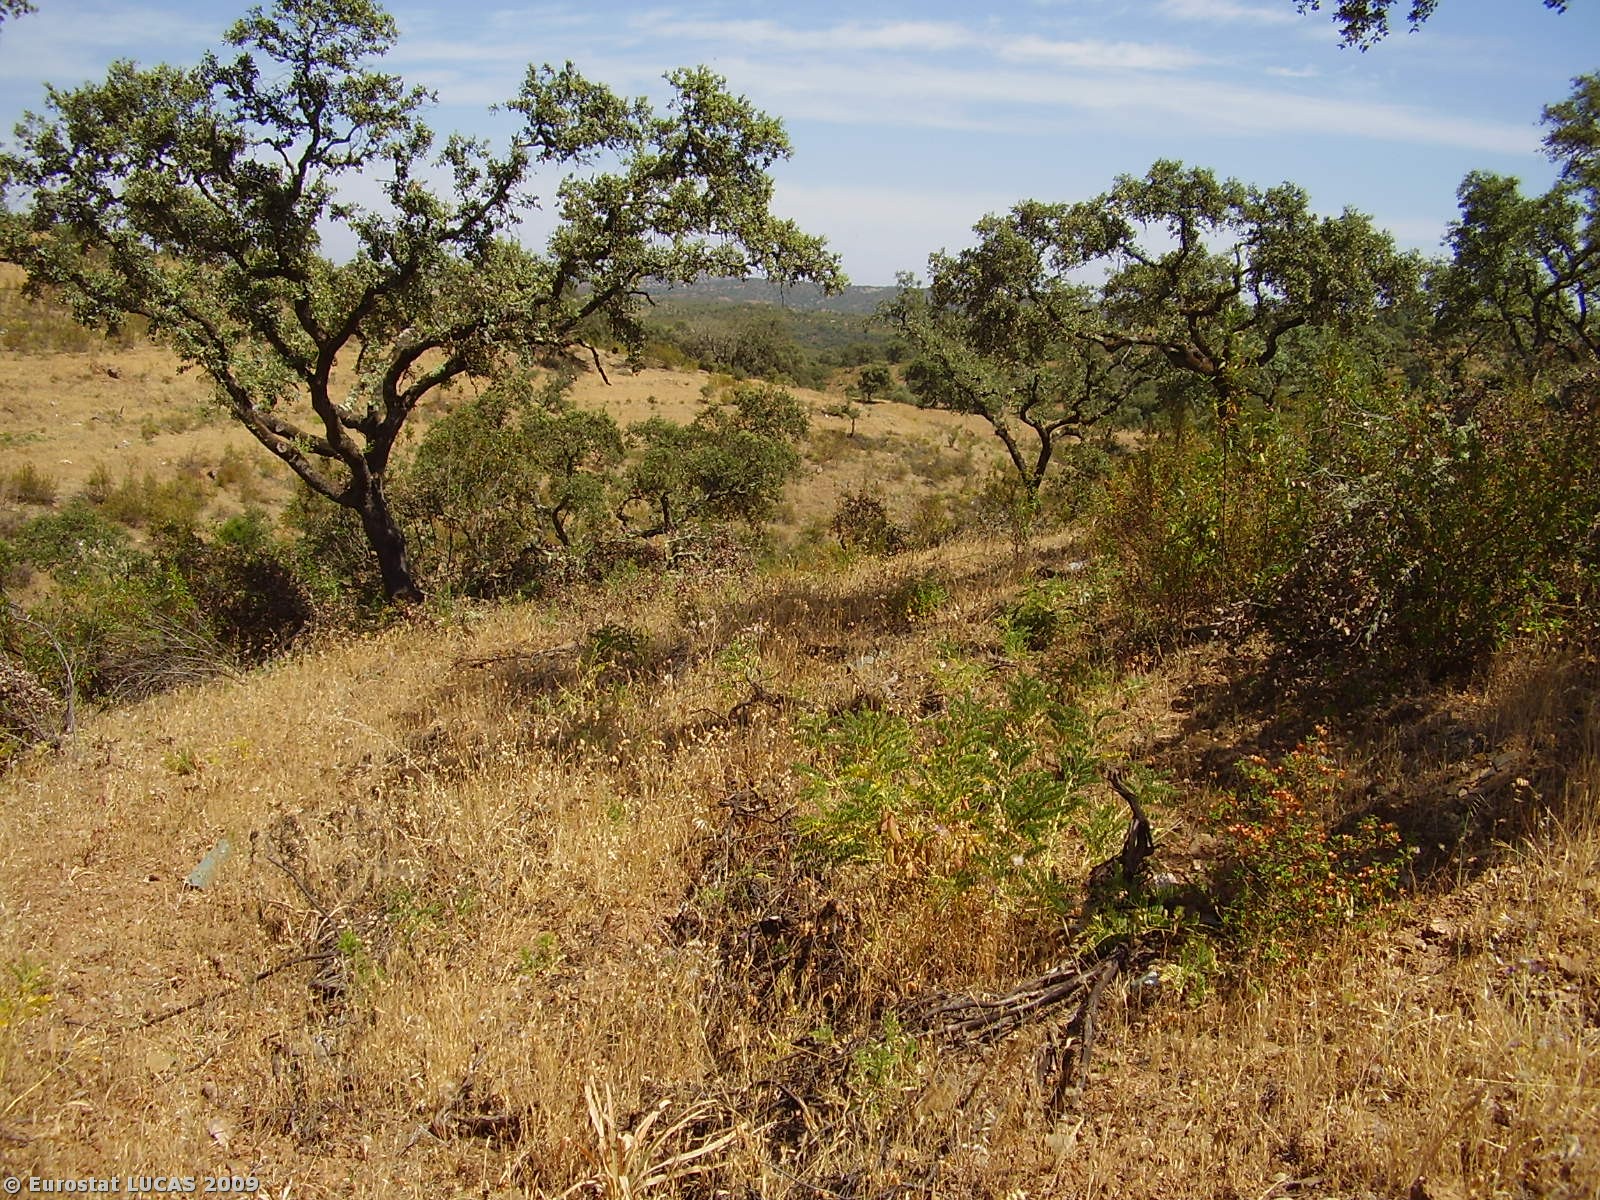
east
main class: Woodland
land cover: Broadleaved woodland
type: broadleaved evergreen forest
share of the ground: 50 - 75 %
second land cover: Spontaneously vegetated surfaces
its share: 50 - 75 %
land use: Forestry
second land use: Fallow land
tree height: > 5 m
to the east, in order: Broadleaved woodland; Spontaneously vegetated surfaces; Shrubland without tree cover; Rivers and streams; Broadleaved woodland; Fences; Bare land; Broadleaved woodland
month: May
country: PT
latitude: 37.7113
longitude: -7.4474
